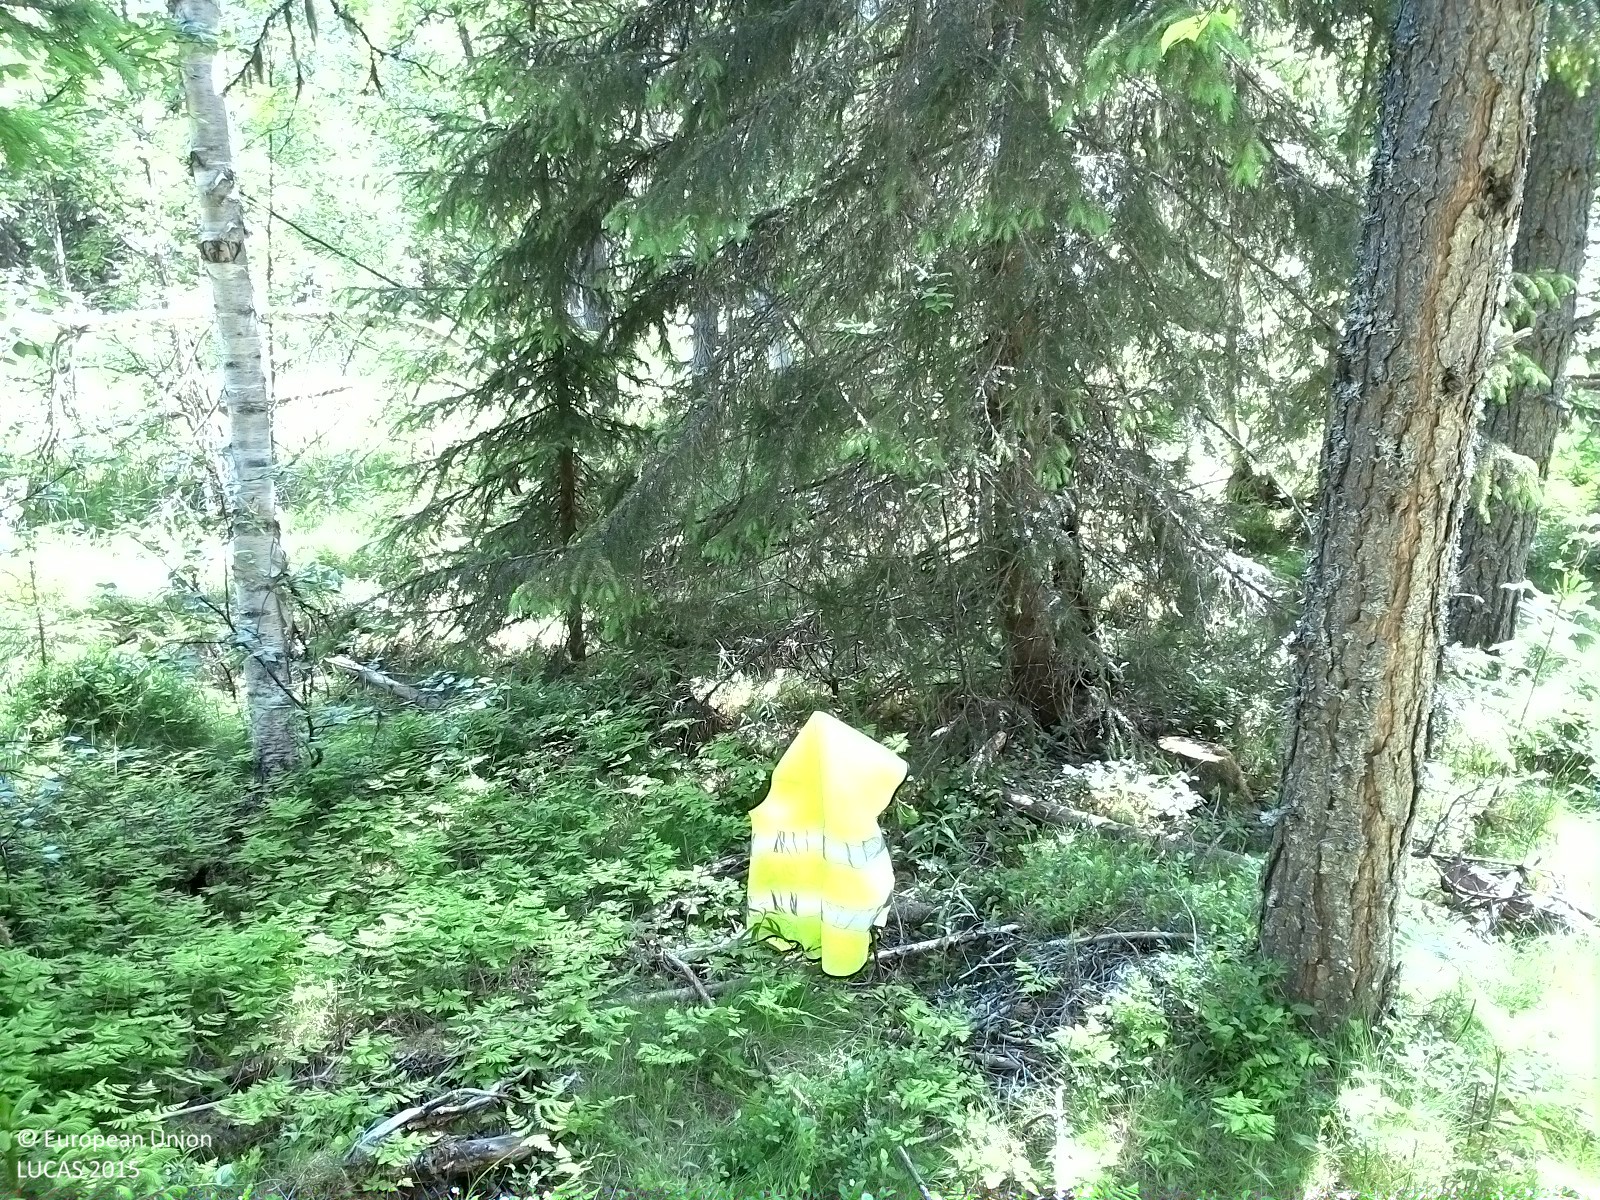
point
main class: Woodland
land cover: Other mixed woodland
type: boreal forest
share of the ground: 25 - 50 %
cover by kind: broadleaved forest trees 30 %, herbaceous plants 30 %, coniferous forest trees 20 %, lichens and mosses 20 %
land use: Forestry
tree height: > 5 m
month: July
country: SE
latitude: 62.1530
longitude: 16.7552
